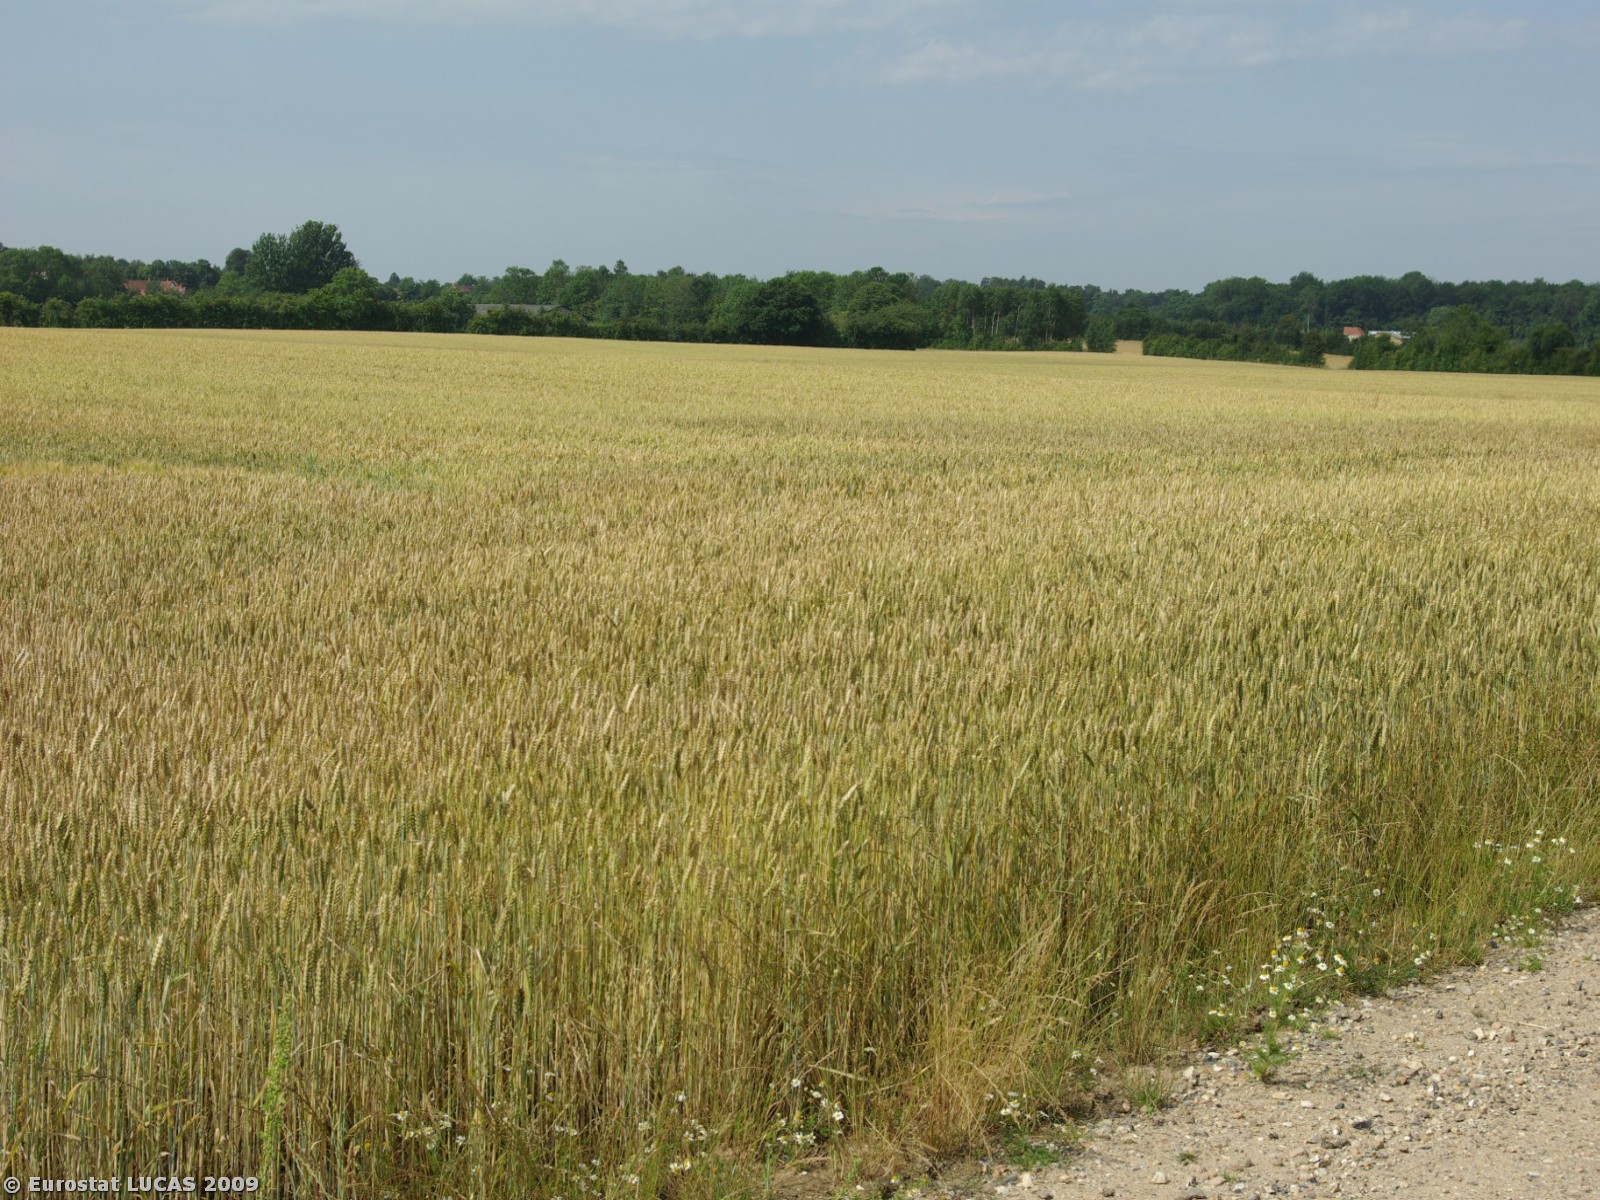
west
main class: Cropland
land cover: Barley
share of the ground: > 75 %
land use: Agriculture (excluding fallow land and kitchen gardens)
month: July
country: DK
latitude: 54.9115
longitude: 9.8597
